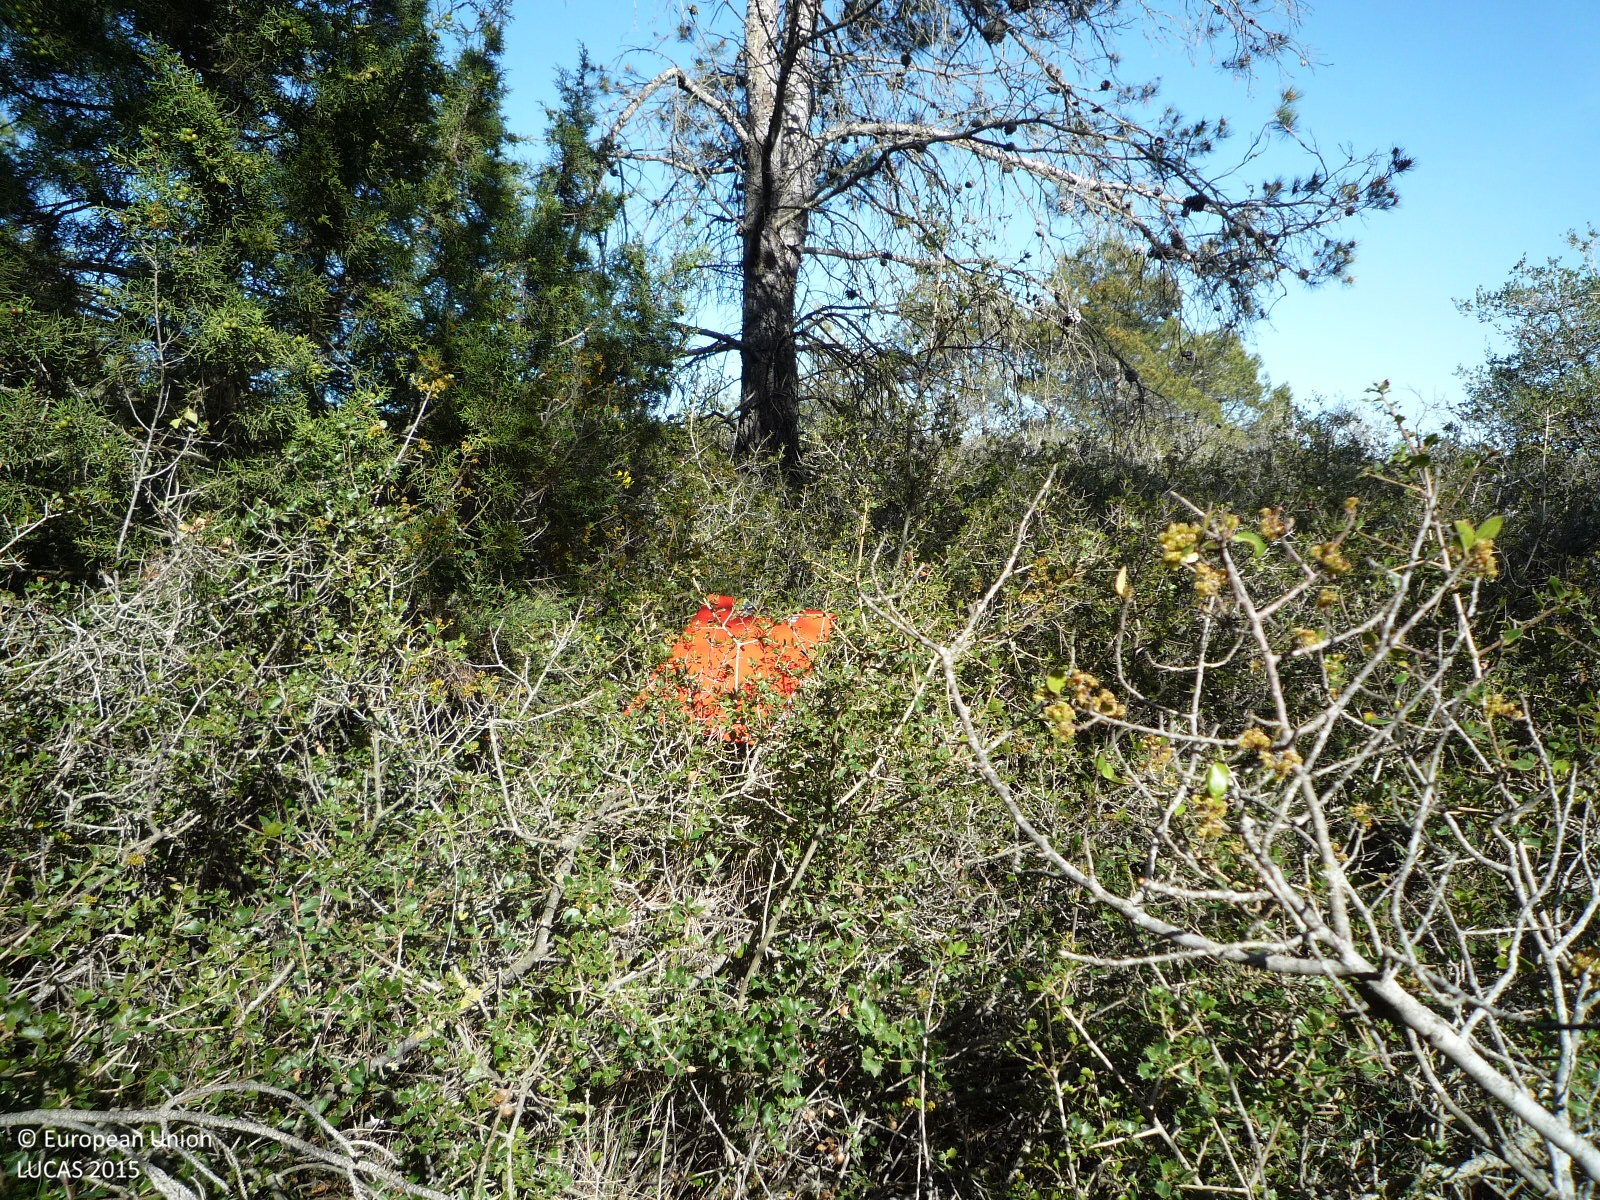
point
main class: Shrubland
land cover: Shrubland with sparse tree cover
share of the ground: > 75 %
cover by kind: shrubs 95 %, coniferous forest trees 5 %
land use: Semi-natural and natural areas not in use
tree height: > 5 m
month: April
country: ES
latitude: 41.4254
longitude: 1.5087
